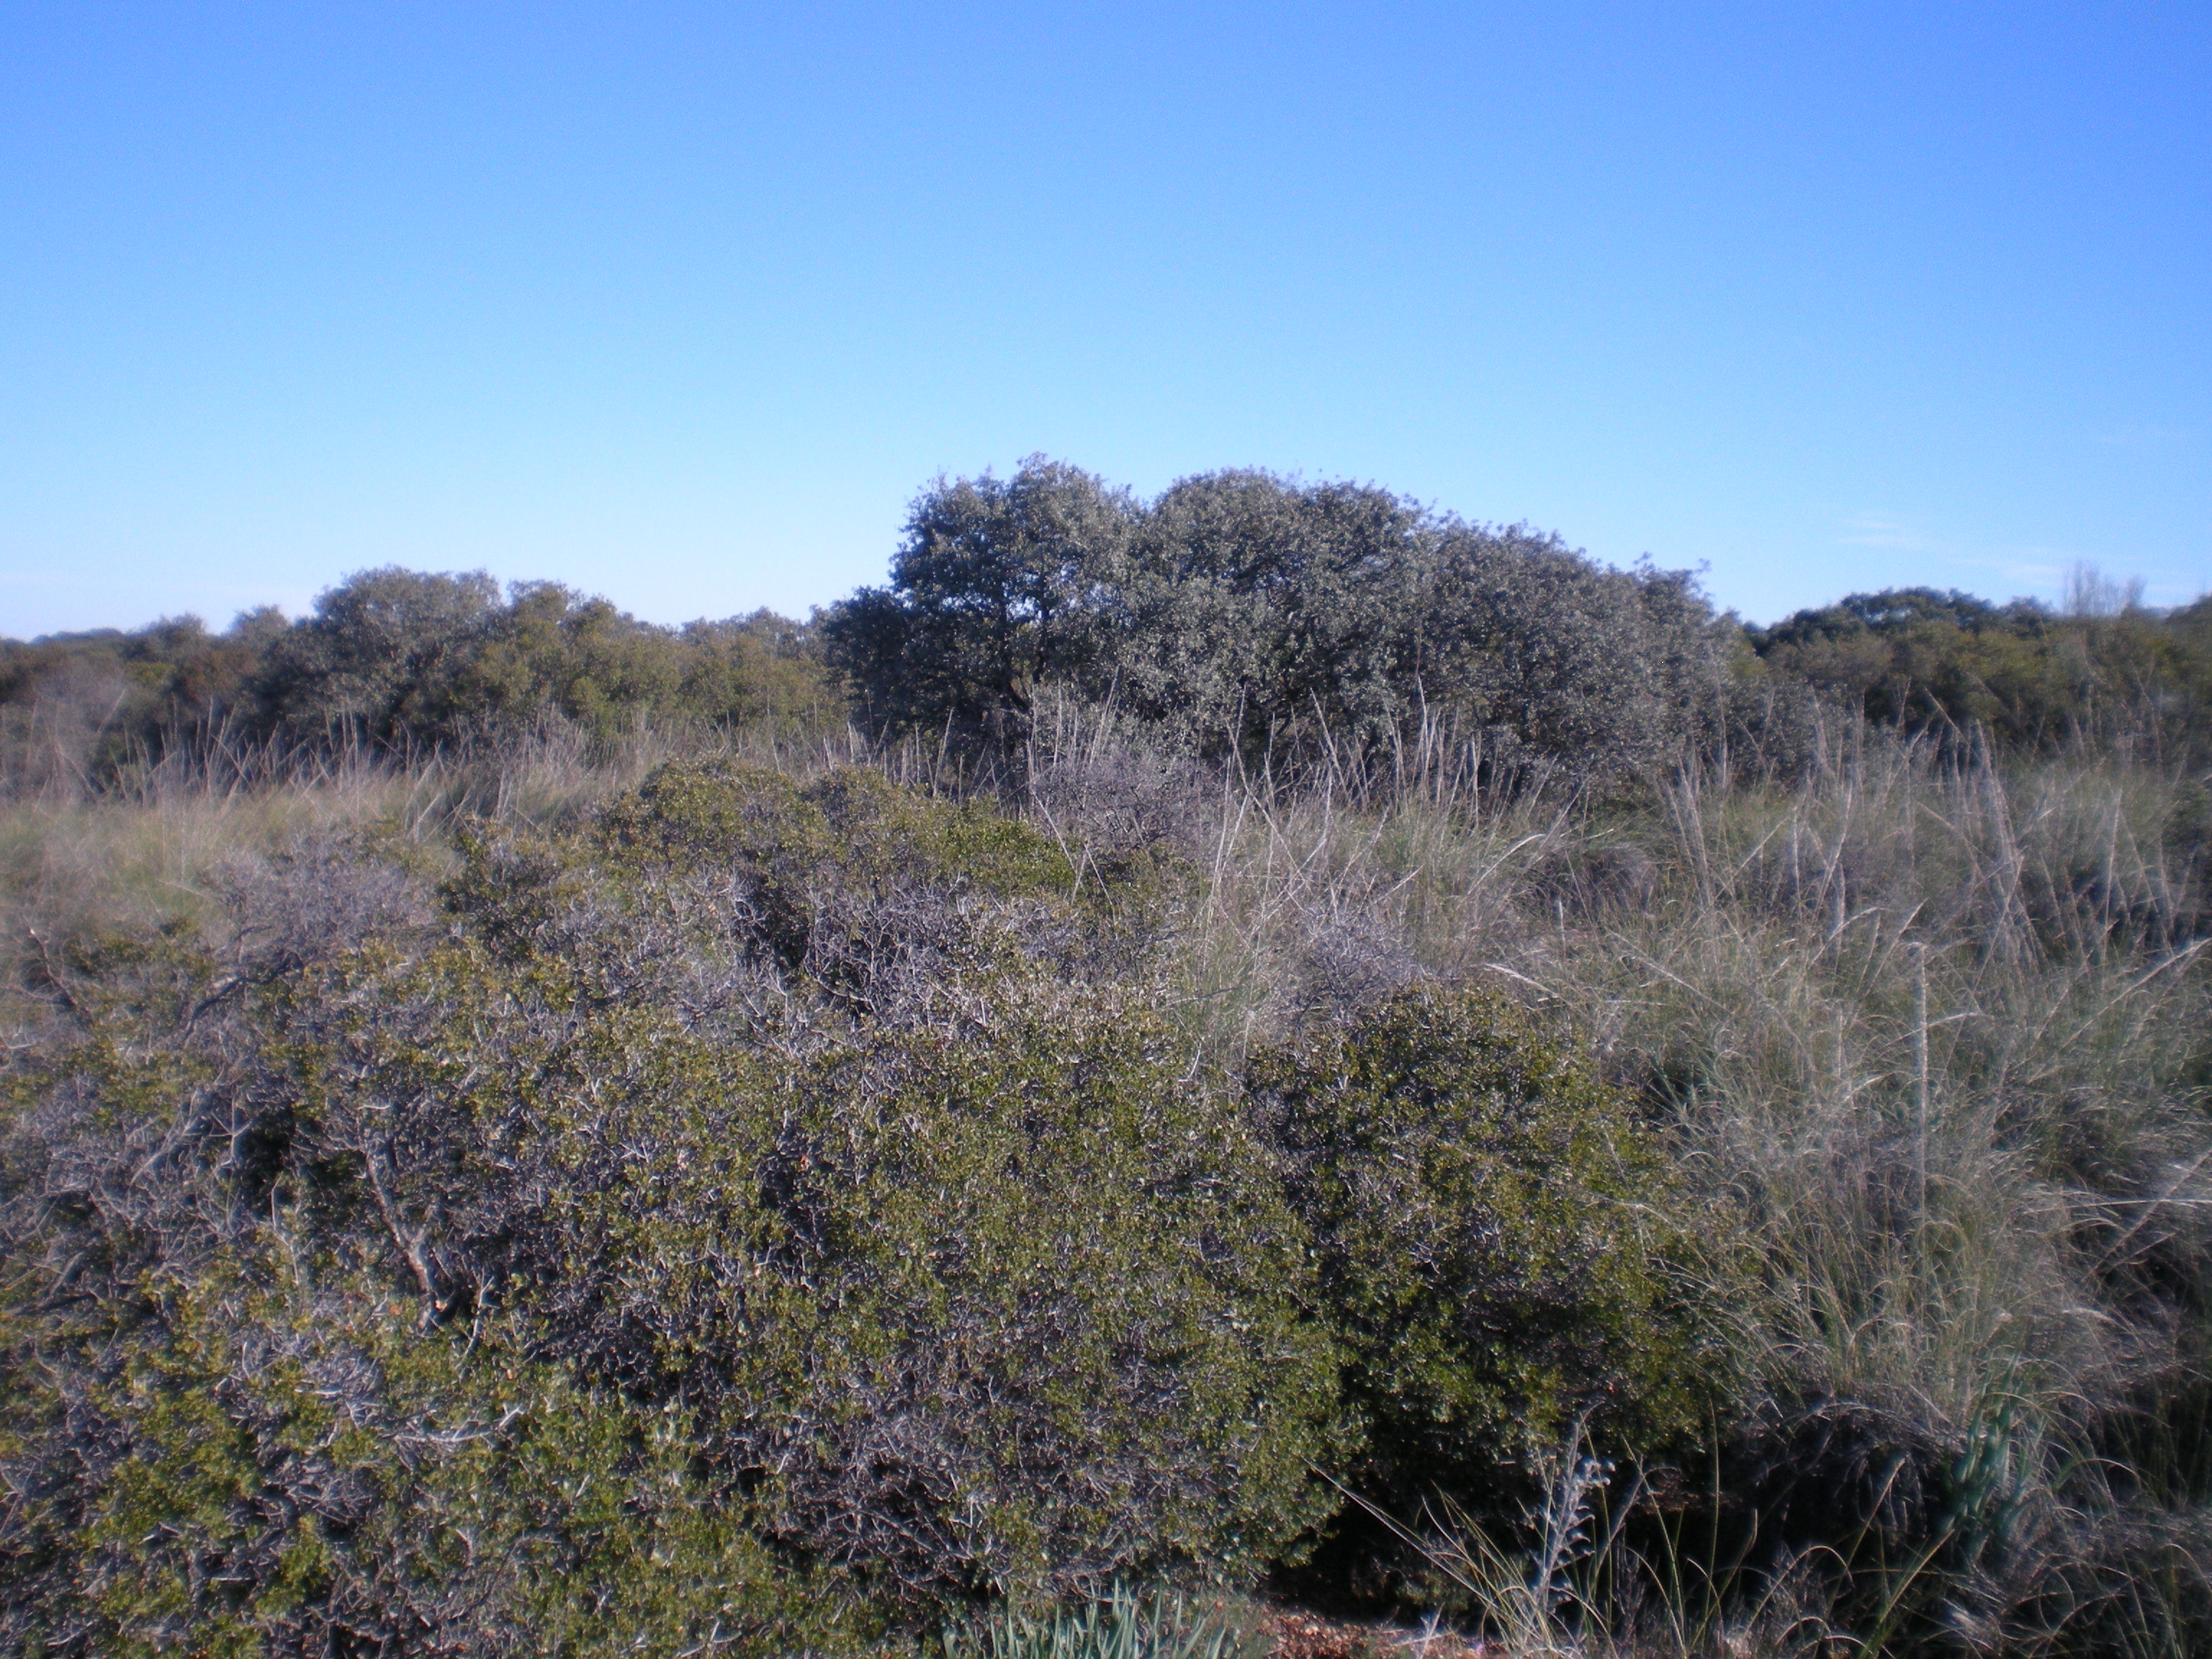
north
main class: Woodland
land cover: Broadleaved woodland
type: broadleaved evergreen forest
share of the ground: 25 - 50 %
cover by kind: shrubs 50 %, broadleaved forest trees 25 %, consolidated bare surface 20 %, herbaceous plants 5 %
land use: Semi-natural and natural areas not in use
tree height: < 5 m
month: April
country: ES
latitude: 38.8290
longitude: -3.0131
